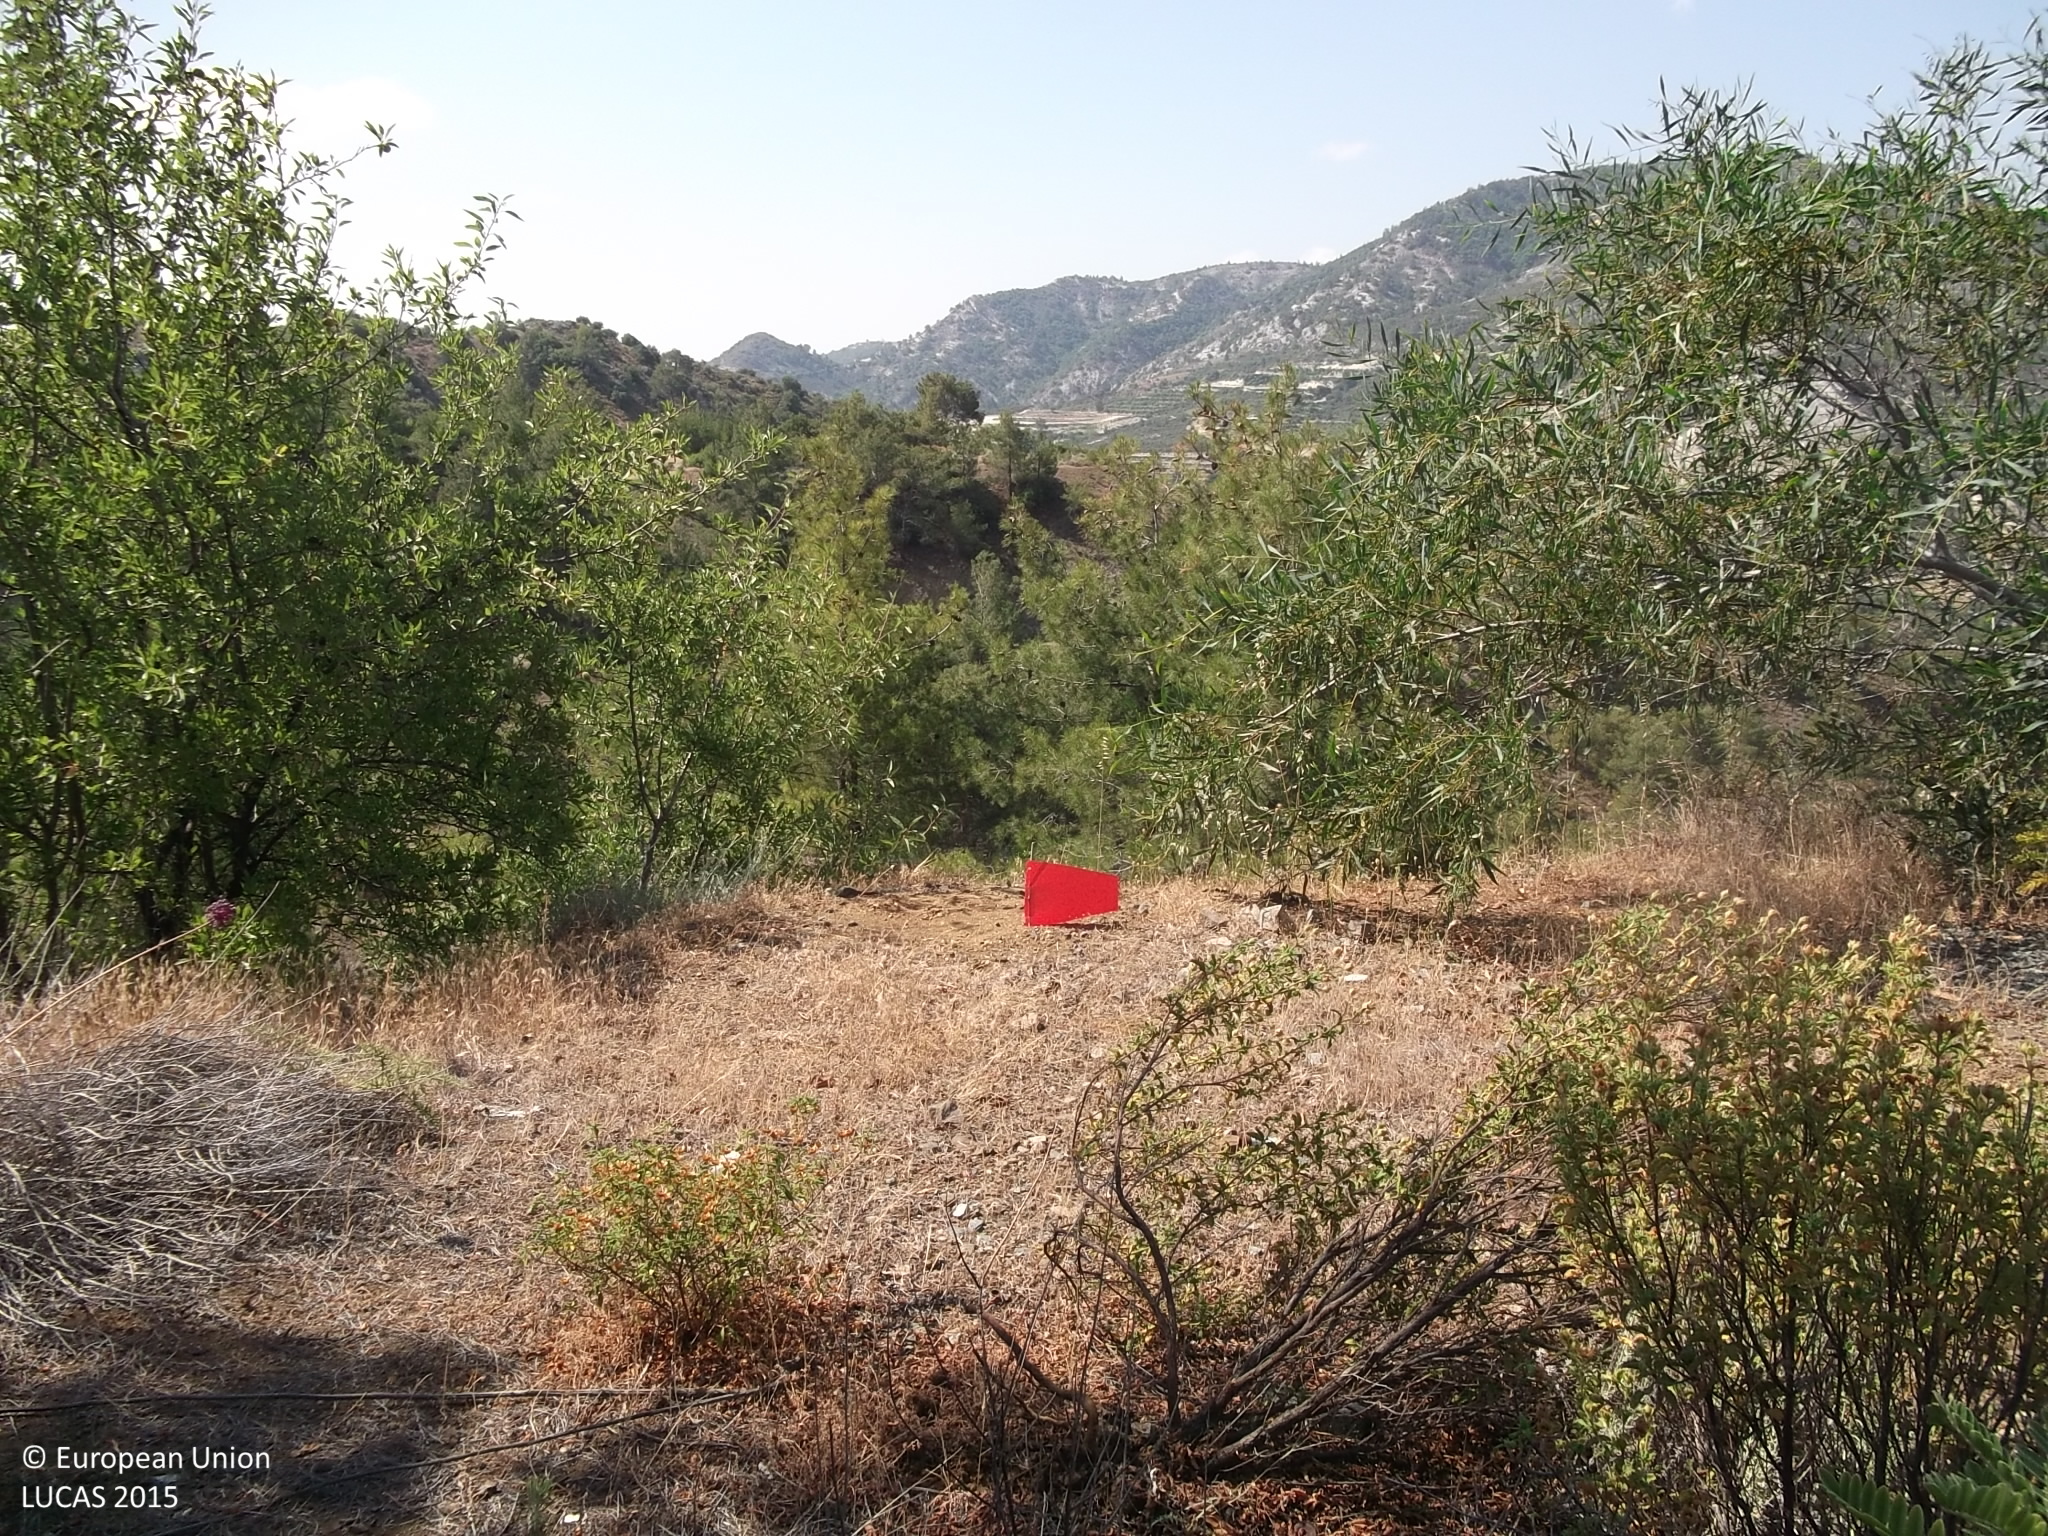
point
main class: Shrubland
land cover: Shrubland with sparse tree cover
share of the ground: > 75 %
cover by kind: shrubs 95 %, broadleaved forest trees 5 %
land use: Semi-natural and natural areas not in use
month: June
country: CY
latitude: 34.8678
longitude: 32.9312
